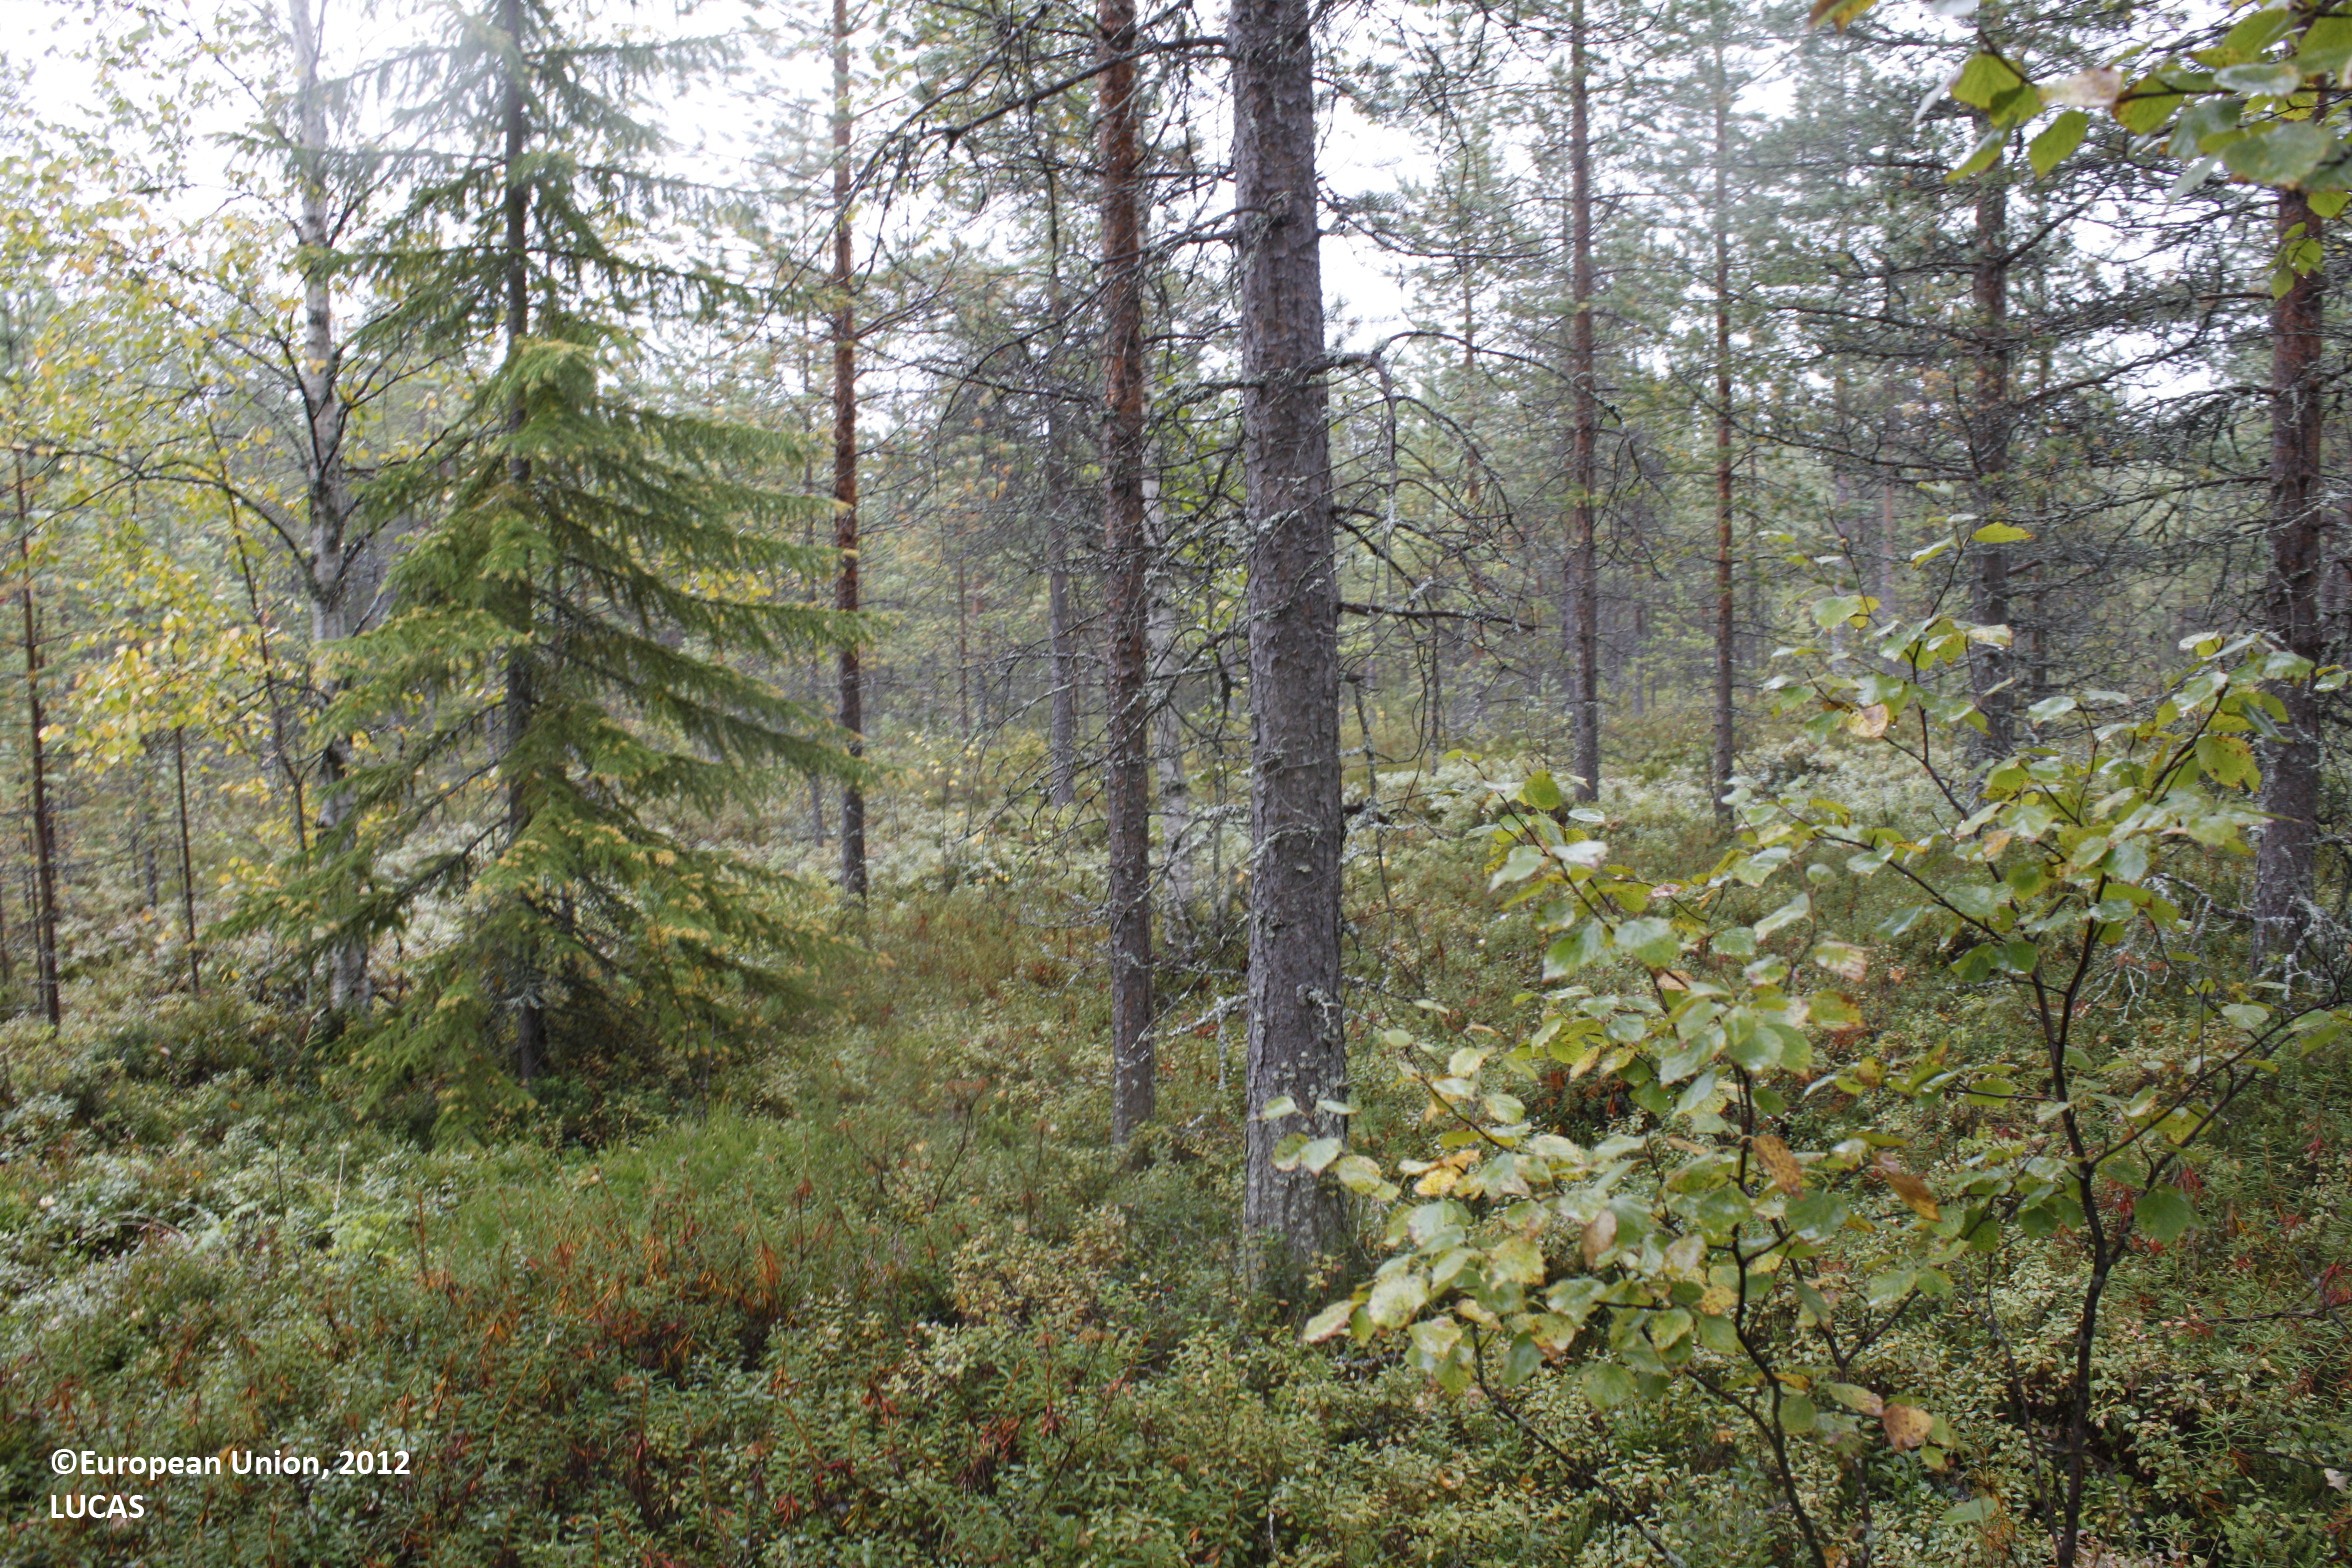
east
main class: Woodland
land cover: Pine dominated mixed woodland
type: mire and swamp forests
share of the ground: 25 - 50 %
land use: Forestry
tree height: > 5 m
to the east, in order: Pine dominated mixed woodland; Ditches and canals; Pine dominated mixed woodland; Ditches and canals; Peatbogs; Pine dominated coniferous woodland; Ditches and canals; Pine dominated coniferous woodland
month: September
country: FI
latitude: 65.3362
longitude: 26.9315
